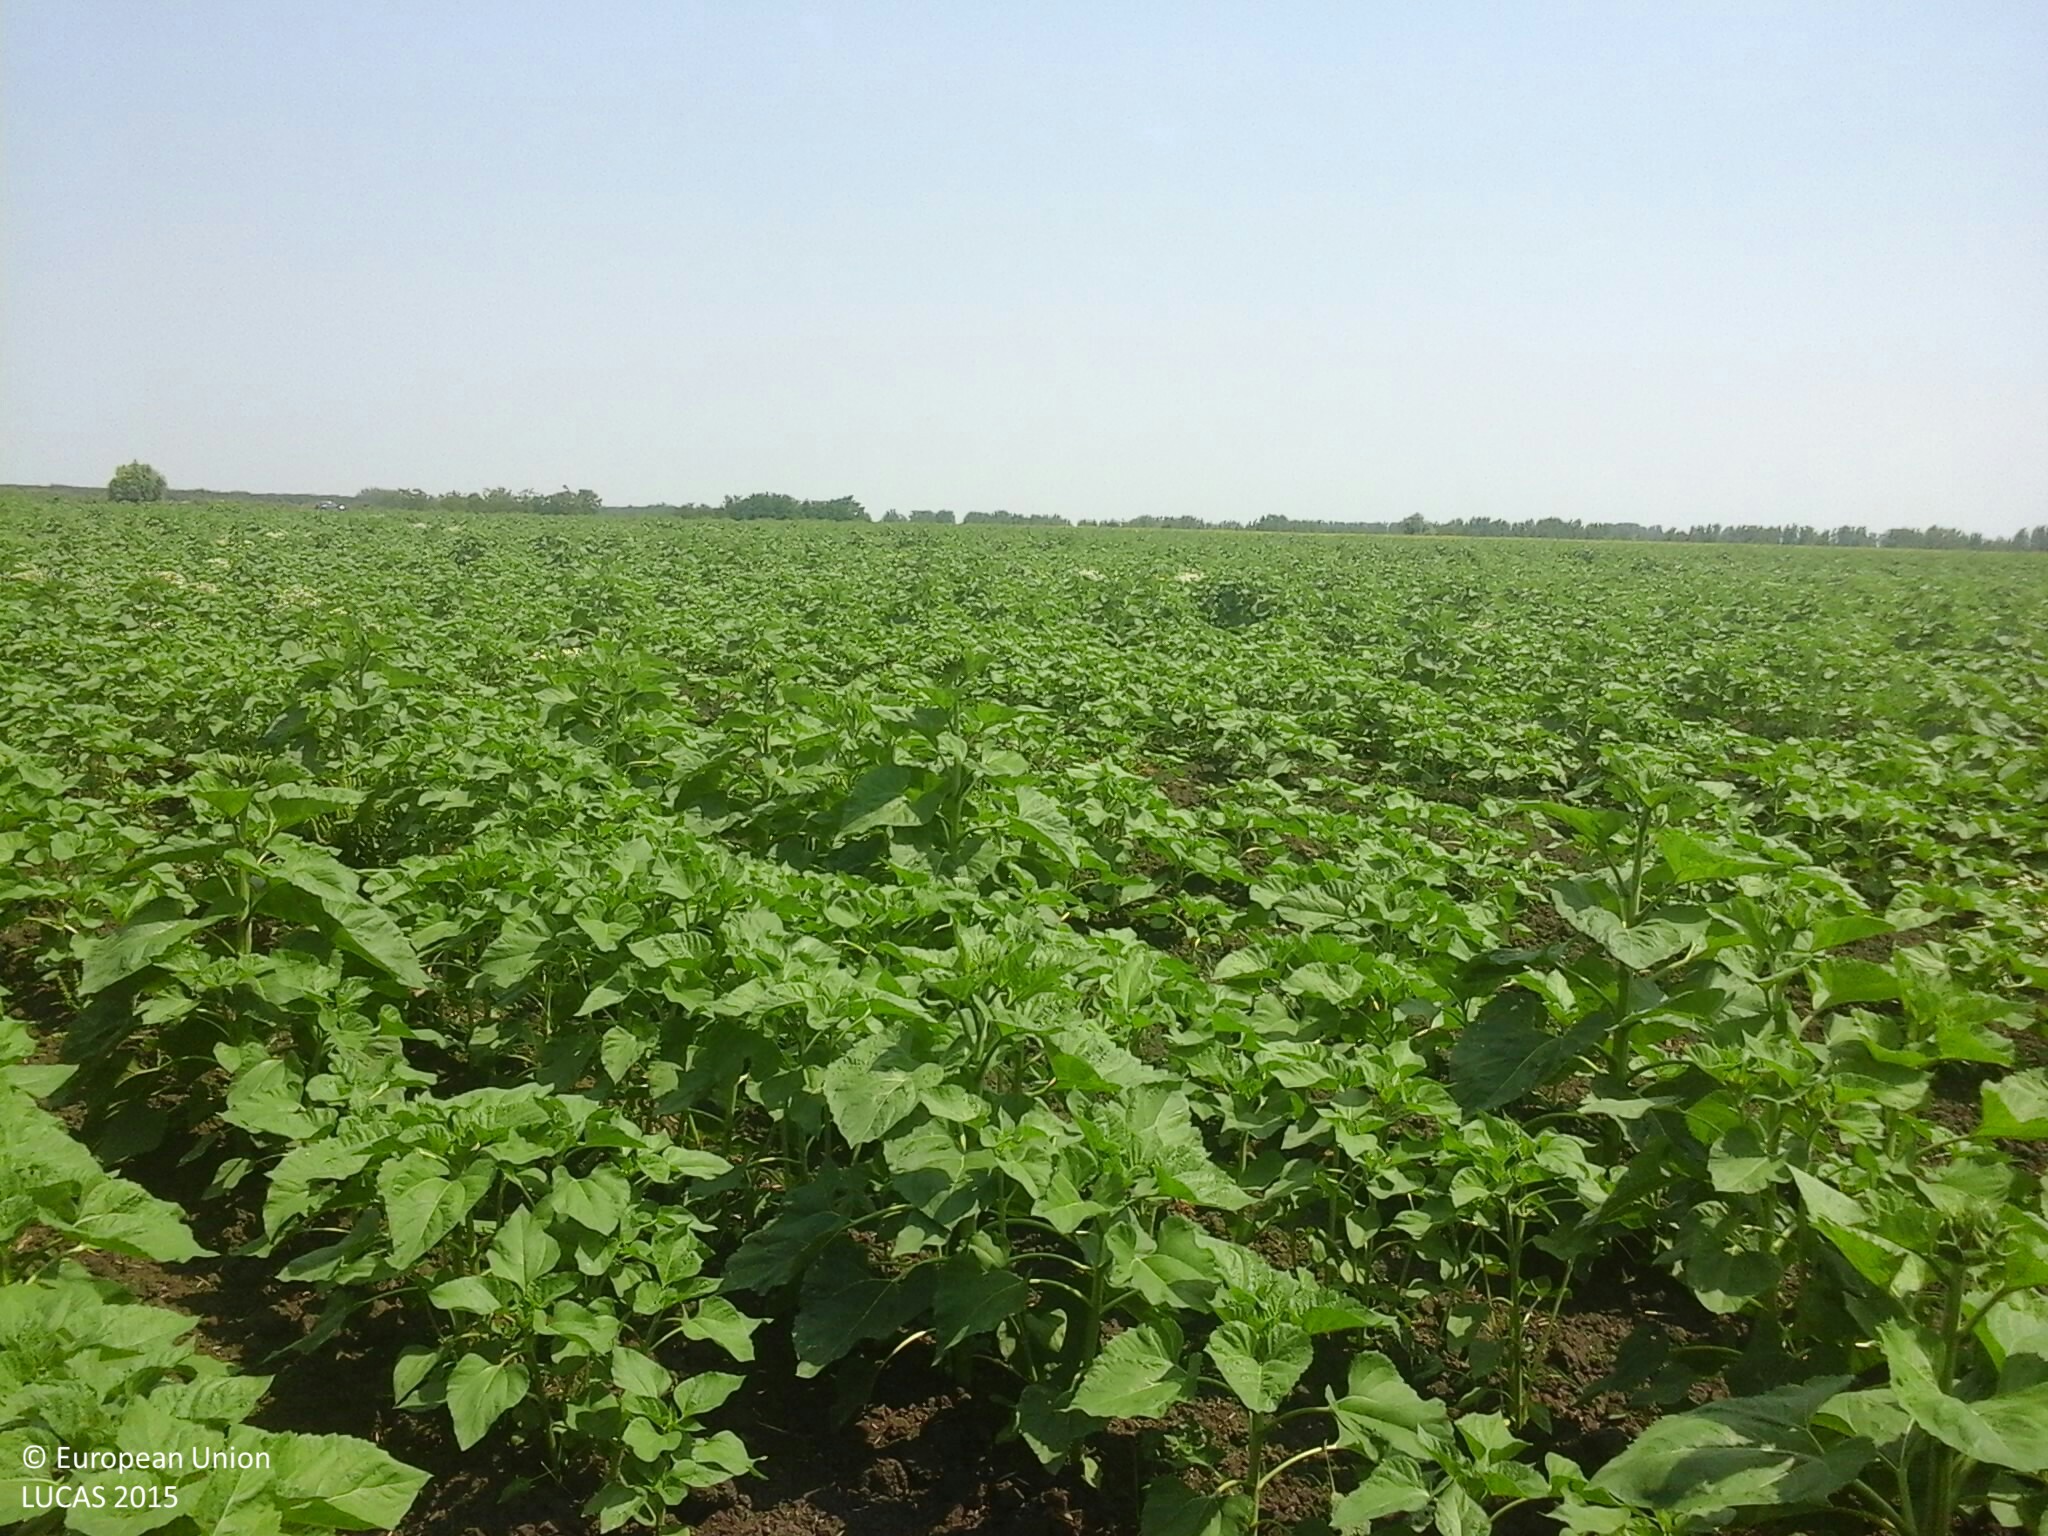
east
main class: Cropland
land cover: Sunflower
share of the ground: 50 - 75 %
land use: Agriculture (excluding fallow land and kitchen gardens)
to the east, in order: Sunflower
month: July
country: HU
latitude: 46.8616
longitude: 20.3766
